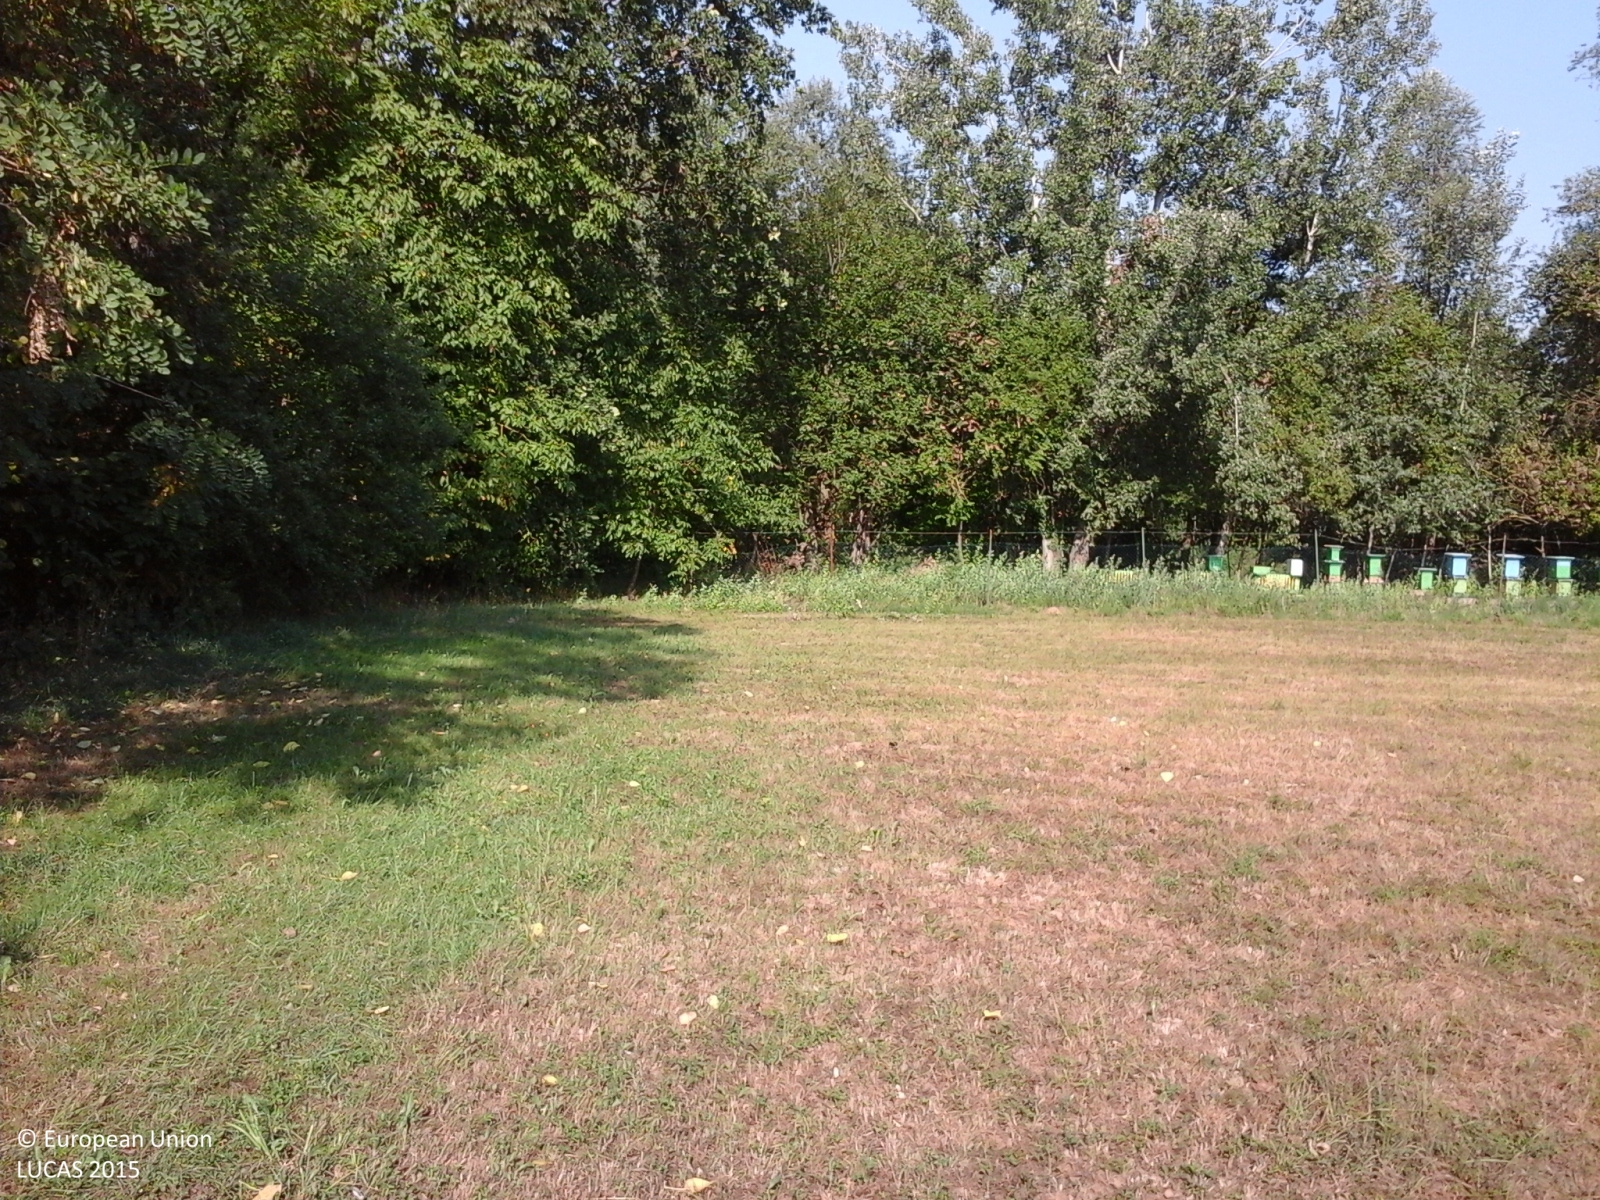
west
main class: Grassland
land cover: Grassland without tree/shrub cover
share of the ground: > 75 %
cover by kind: herbaceous plants 100 %
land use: Agriculture (excluding fallow land and kitchen gardens)
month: August
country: IT
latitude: 44.3815
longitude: 7.8082
